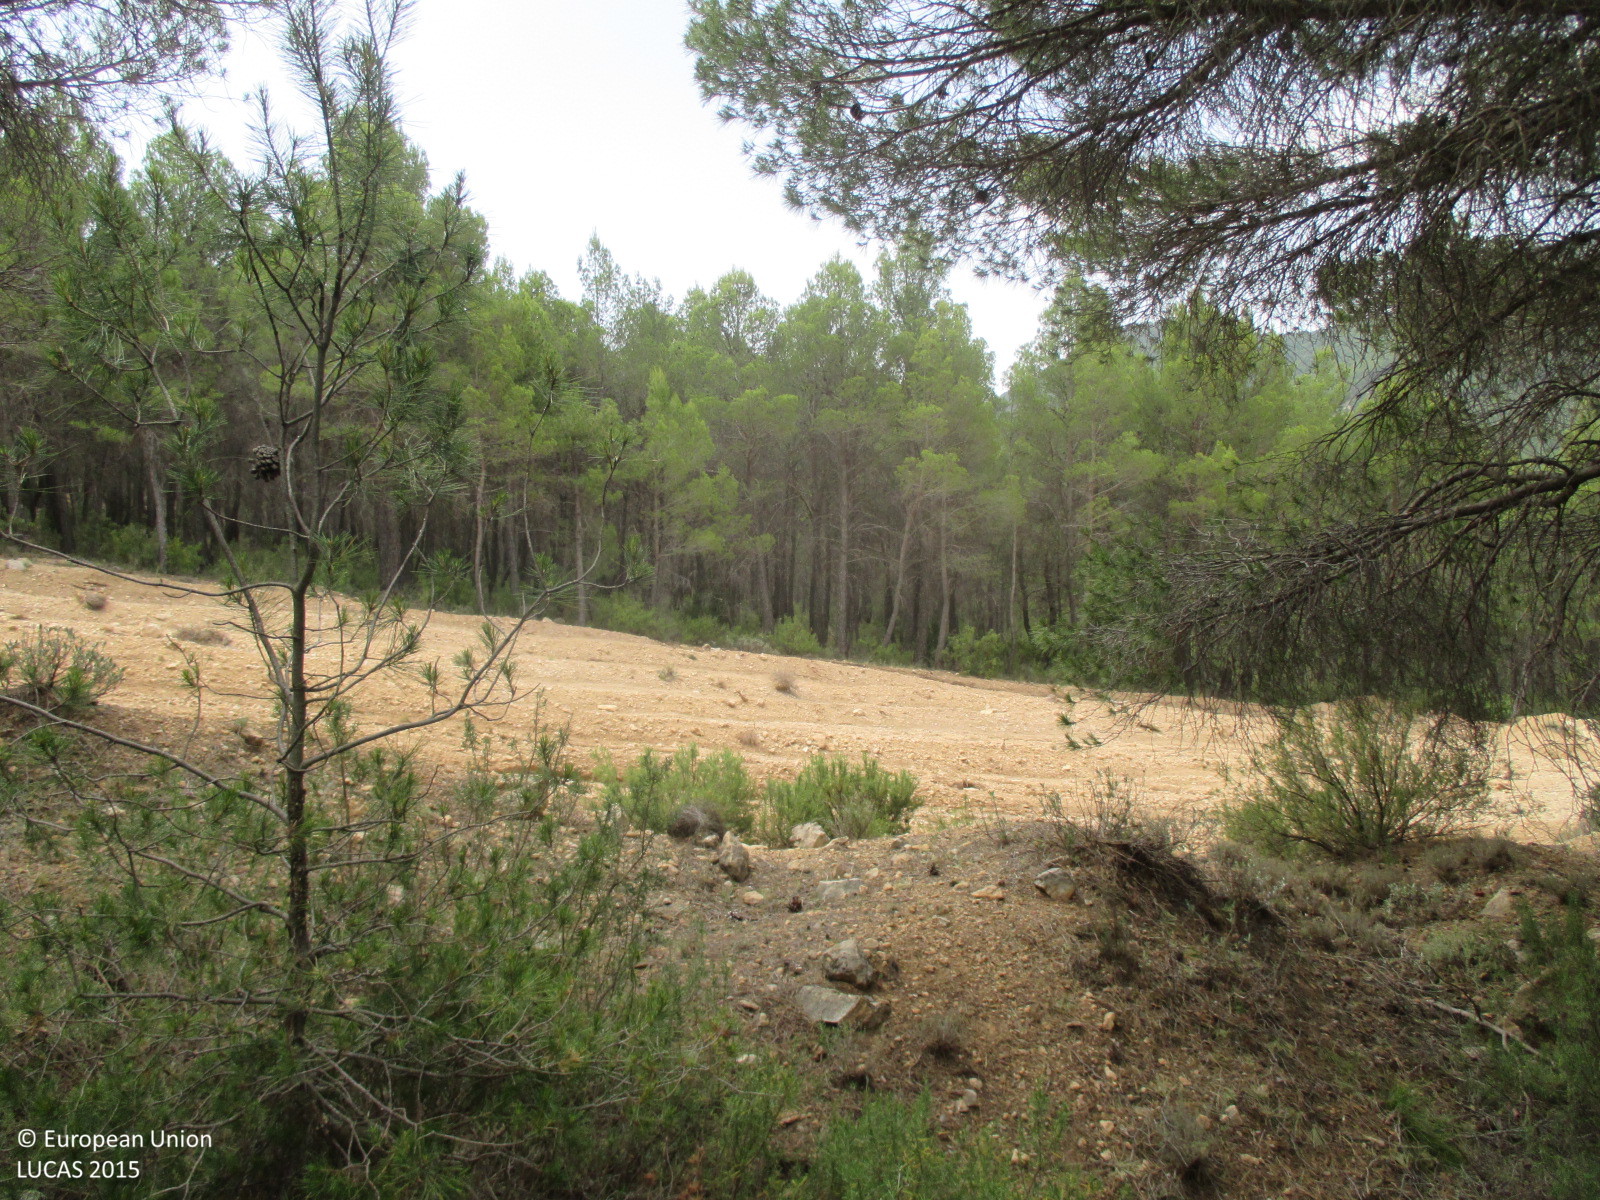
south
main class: Woodland
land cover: Pine dominated coniferous woodland
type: coniferous forest of the mediterranean region
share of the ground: > 75 %
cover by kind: coniferous forest trees 90 %, shrubs 10 %
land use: Forestry
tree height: > 5 m
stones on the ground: < 10 %
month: July
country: ES
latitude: 37.9279
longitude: -2.4943
